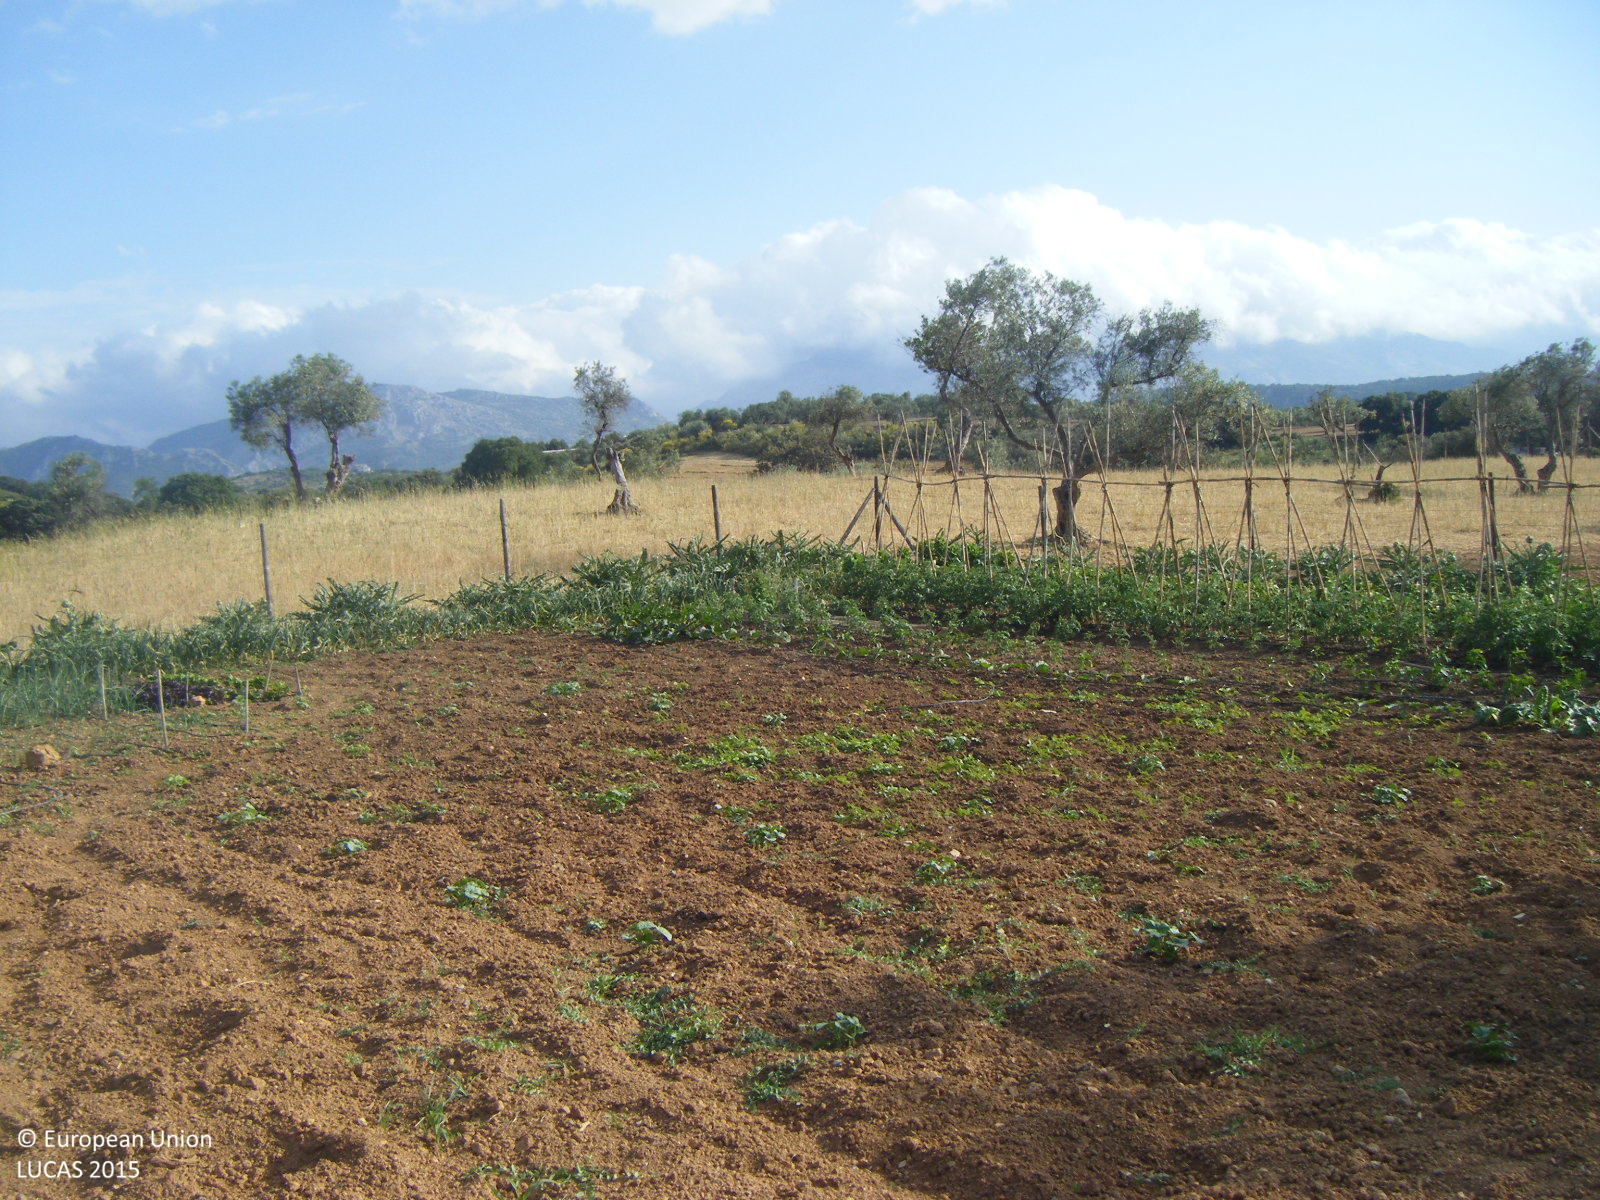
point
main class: Cropland
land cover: Olive groves
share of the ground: < 10 %
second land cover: Spontaneously vegetated surfaces
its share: > 75 %
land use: Agriculture (excluding fallow land and kitchen gardens)
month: May
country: ES
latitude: 37.0466
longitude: -4.4215
